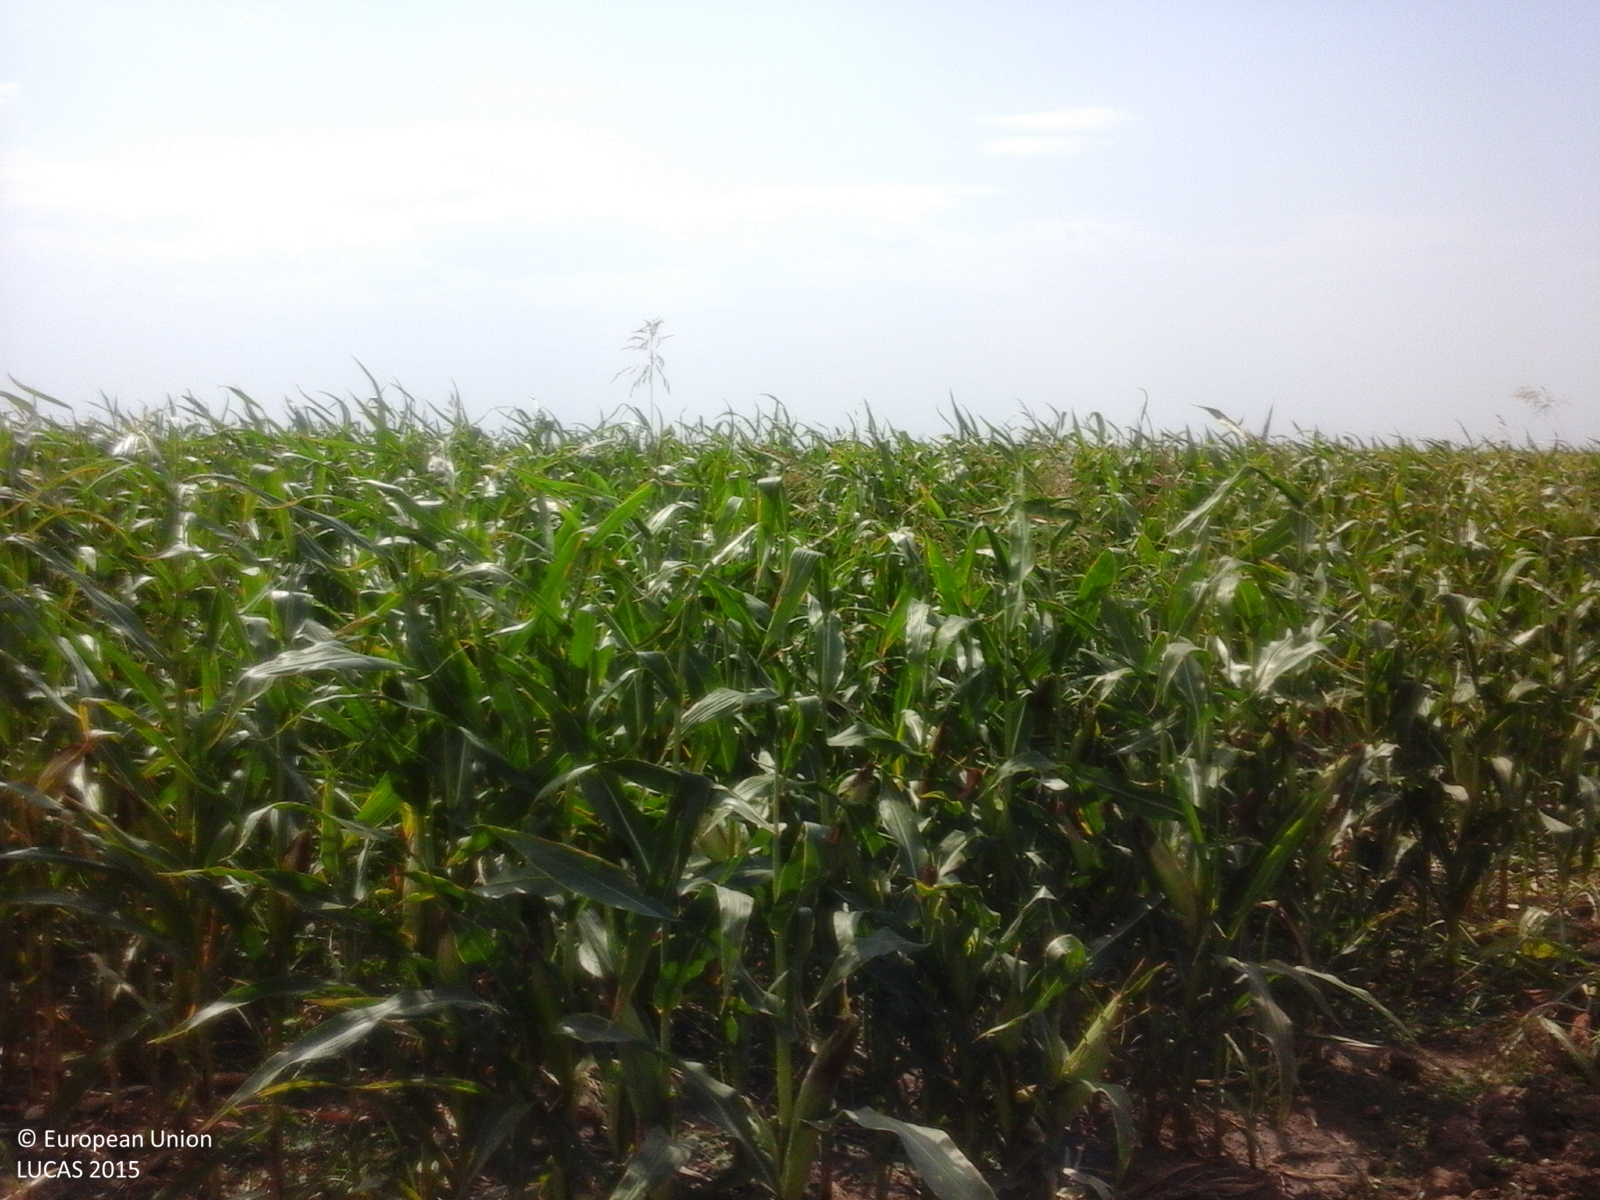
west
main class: Cropland
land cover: Maize
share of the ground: > 75 %
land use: Agriculture (excluding fallow land and kitchen gardens)
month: August
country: RO
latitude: 45.0985
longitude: 27.7048
